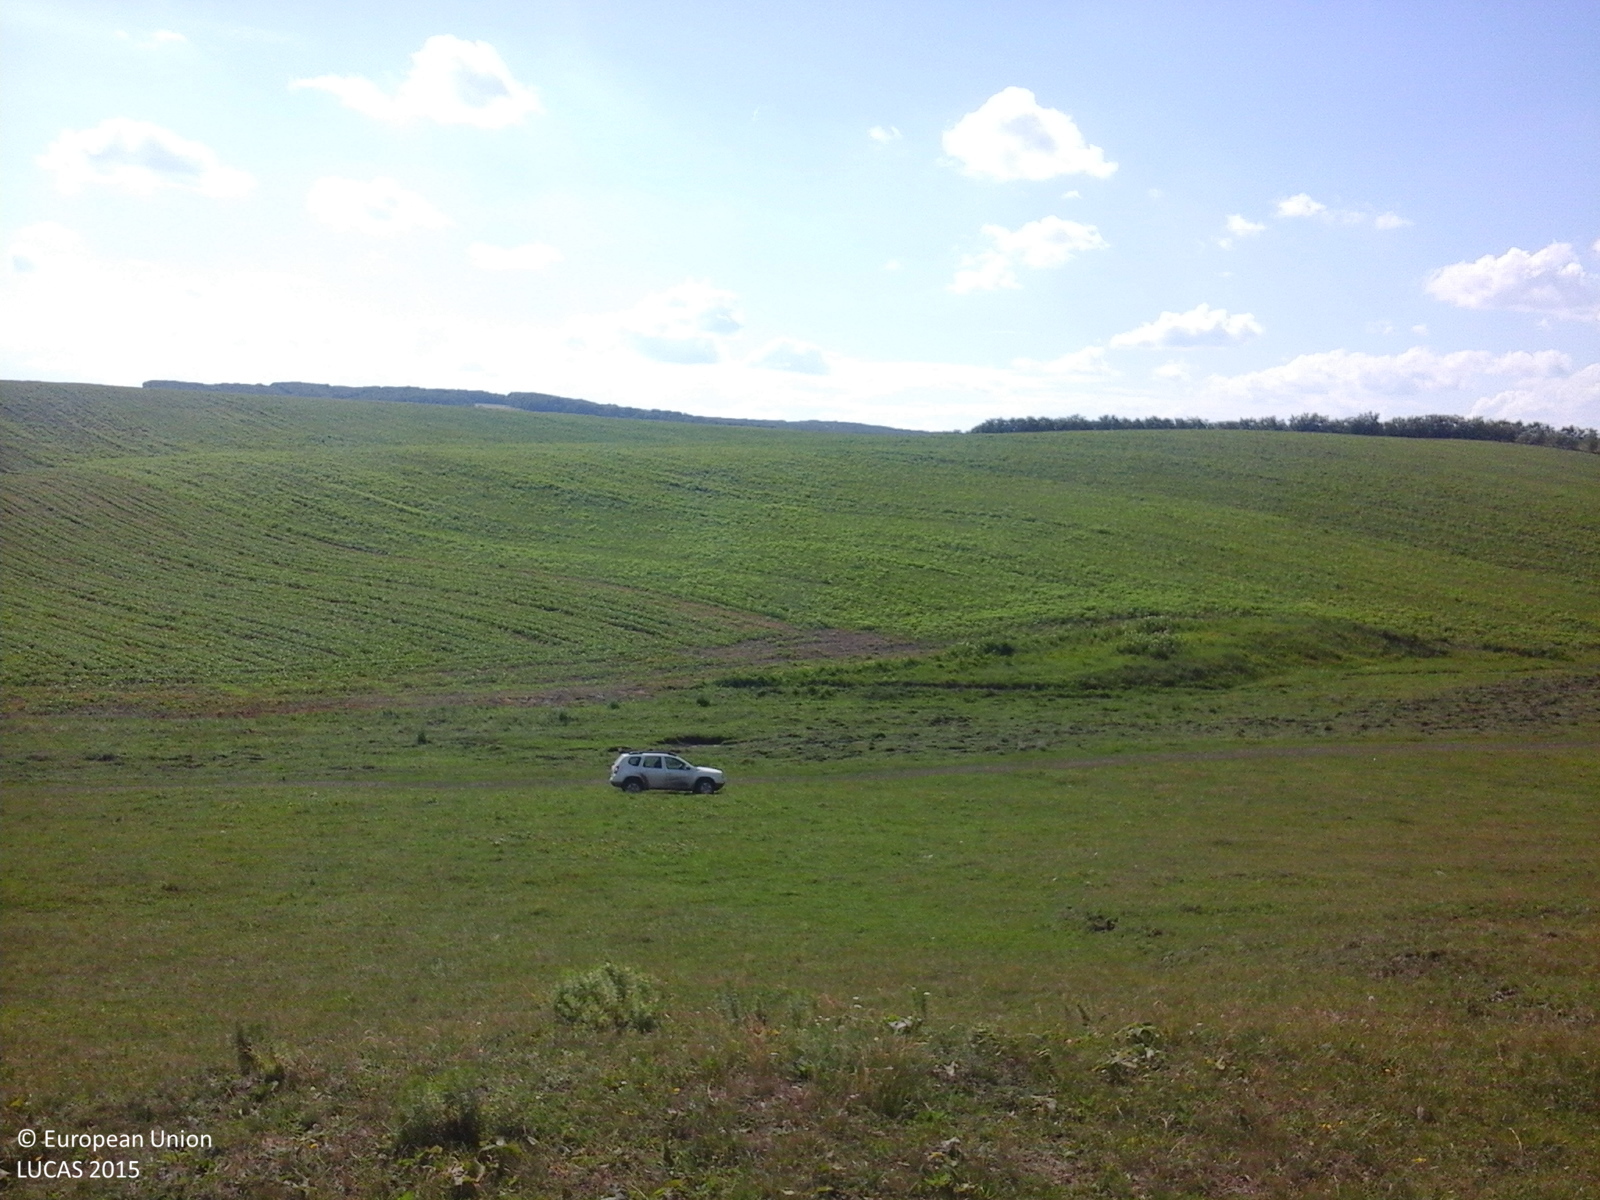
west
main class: Grassland
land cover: Grassland without tree/shrub cover
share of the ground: > 75 %
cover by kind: herbaceous plants 100 %
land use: Agriculture (excluding fallow land and kitchen gardens)
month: June
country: RO
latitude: 48.1934
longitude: 26.6581
